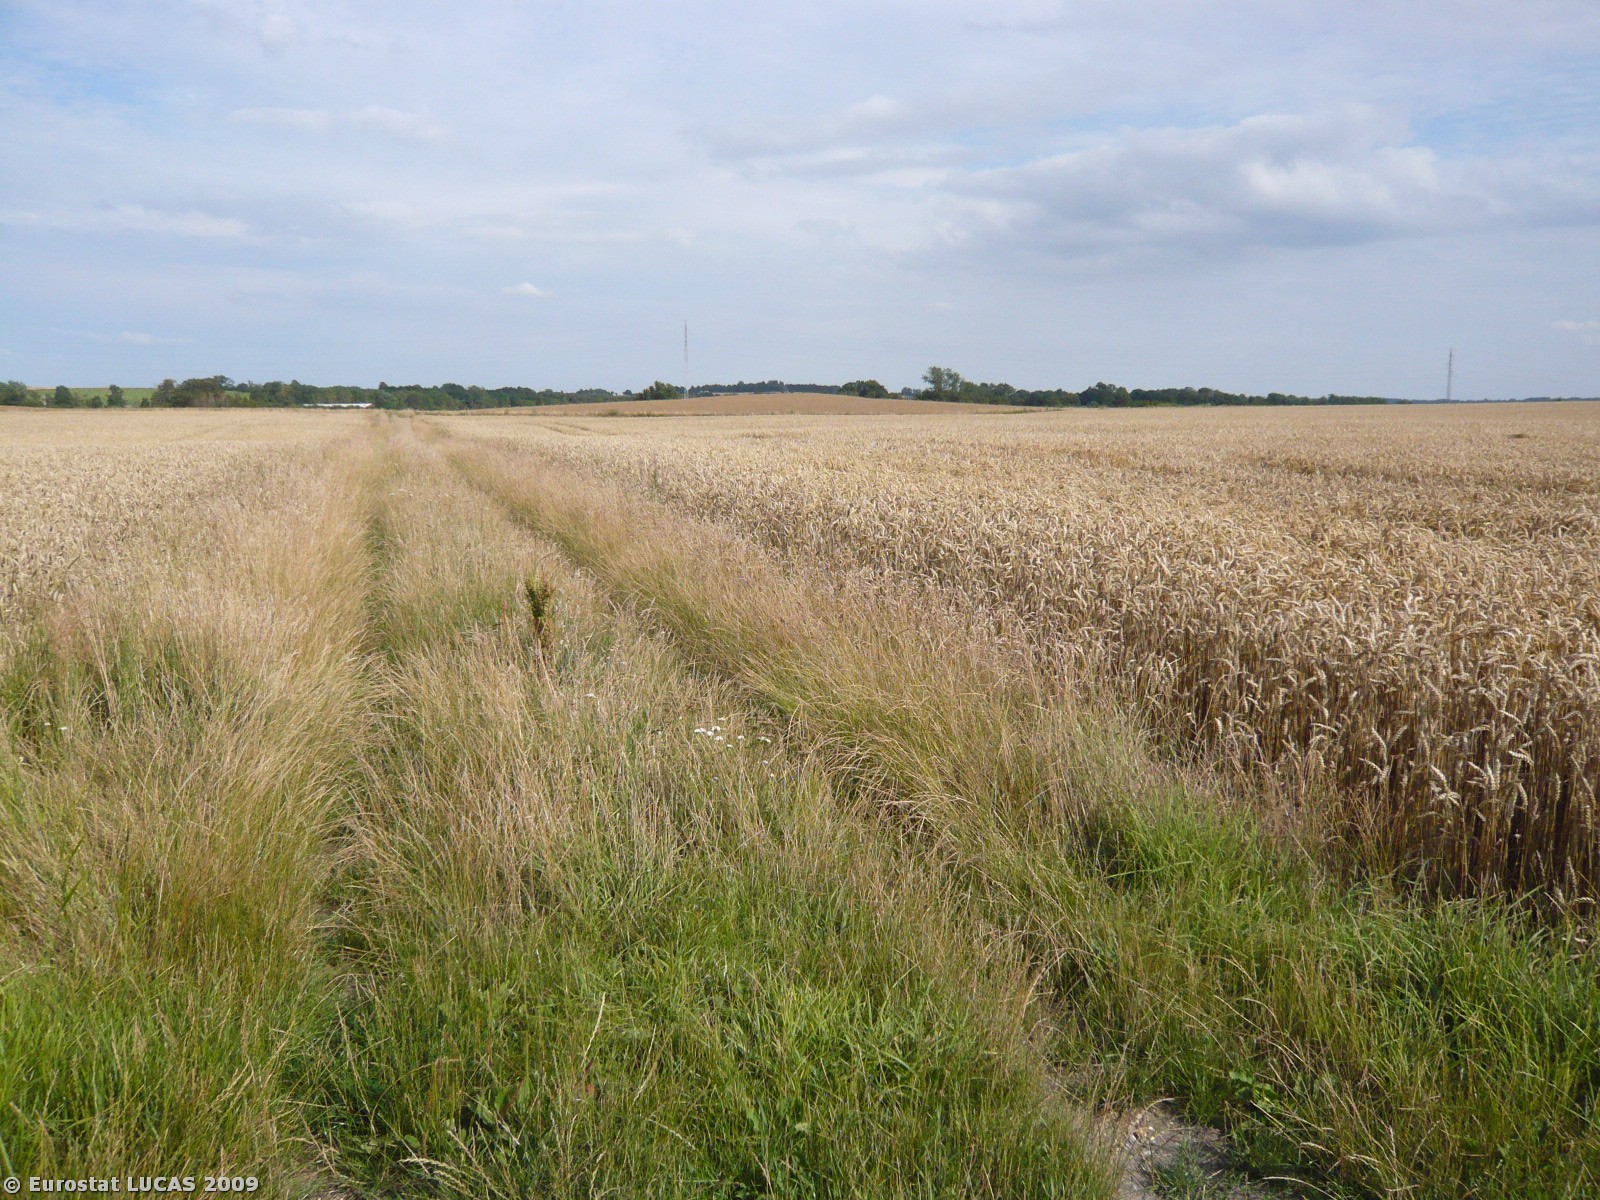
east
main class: Cropland
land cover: Common wheat
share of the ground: > 75 %
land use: Agriculture (excluding fallow land and kitchen gardens)
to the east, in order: Common wheat; Single bushes/trees; Common wheat; Grass margins; Railways; Grass margins; Common wheat
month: August
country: DK
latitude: 56.0953
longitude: 12.2964
